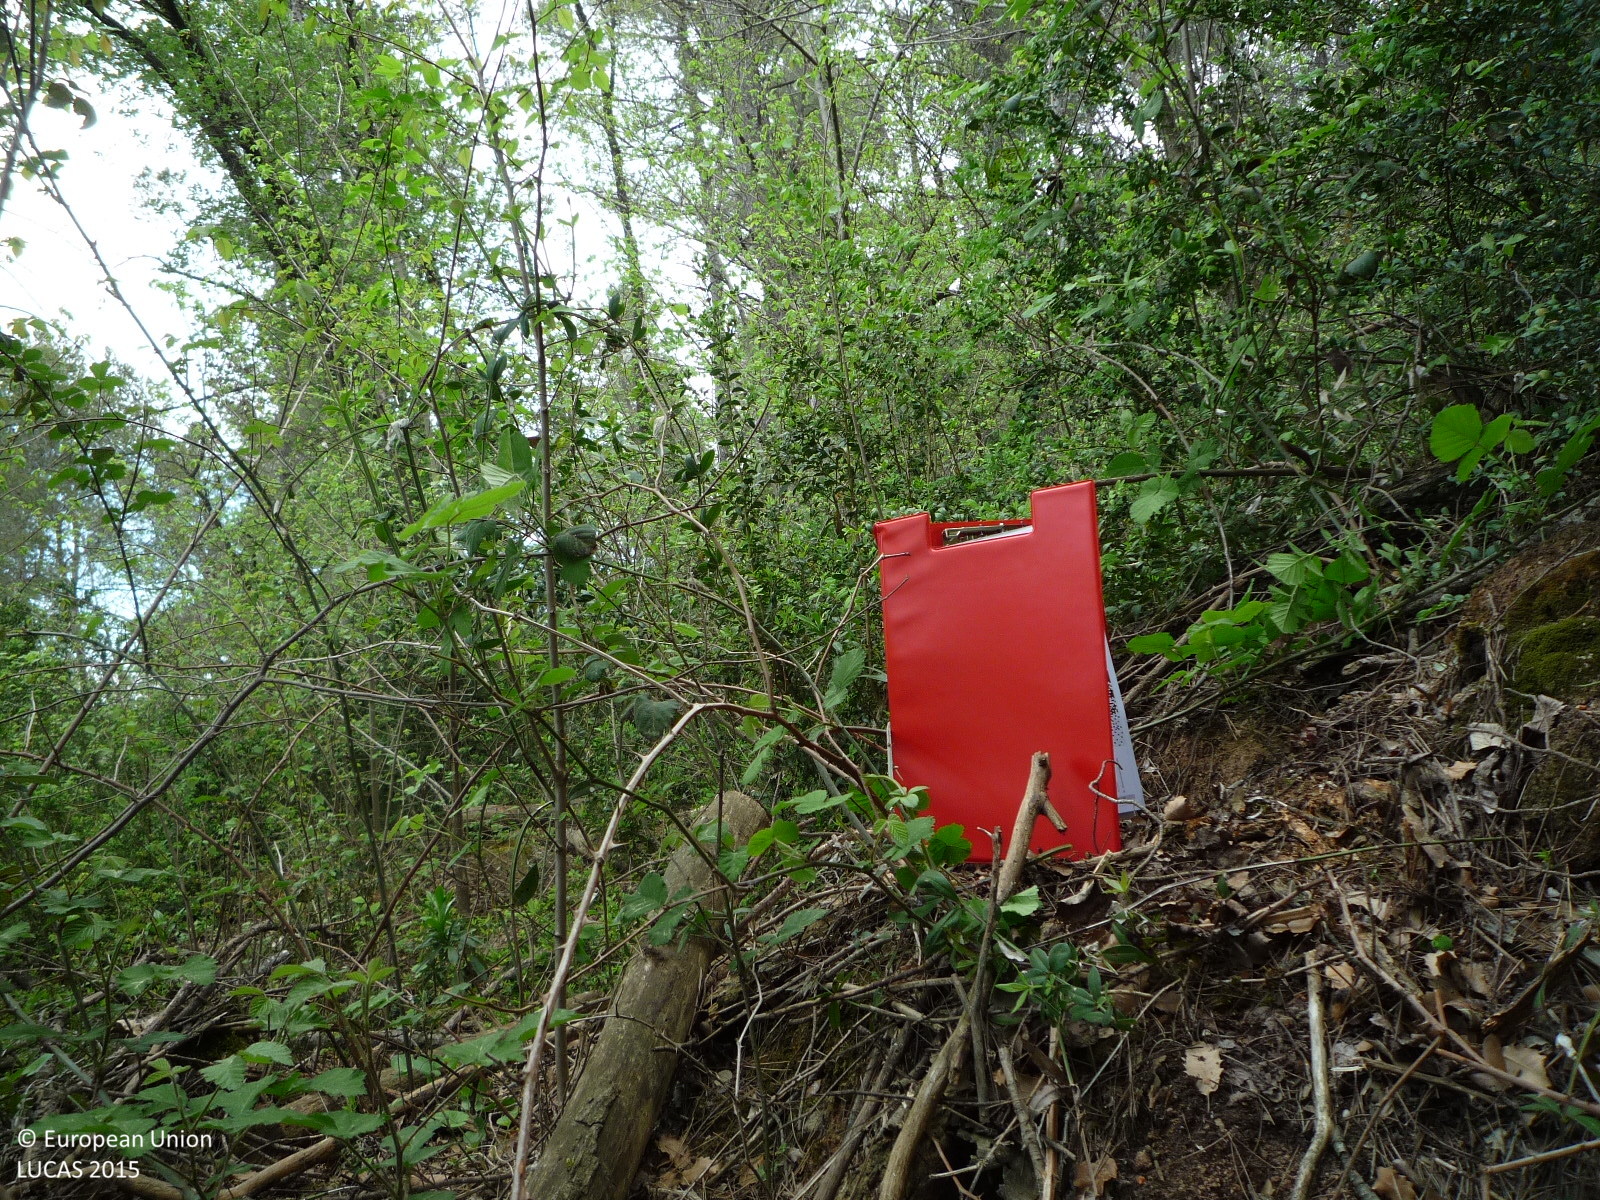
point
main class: Woodland
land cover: Pine dominated mixed woodland
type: coniferous forest of the mediterranean region
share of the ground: > 75 %
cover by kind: coniferous forest trees 75 %, broadleaved forest trees 25 %
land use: Forestry
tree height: > 5 m
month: April
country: ES
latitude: 41.7307
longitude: 1.6834
